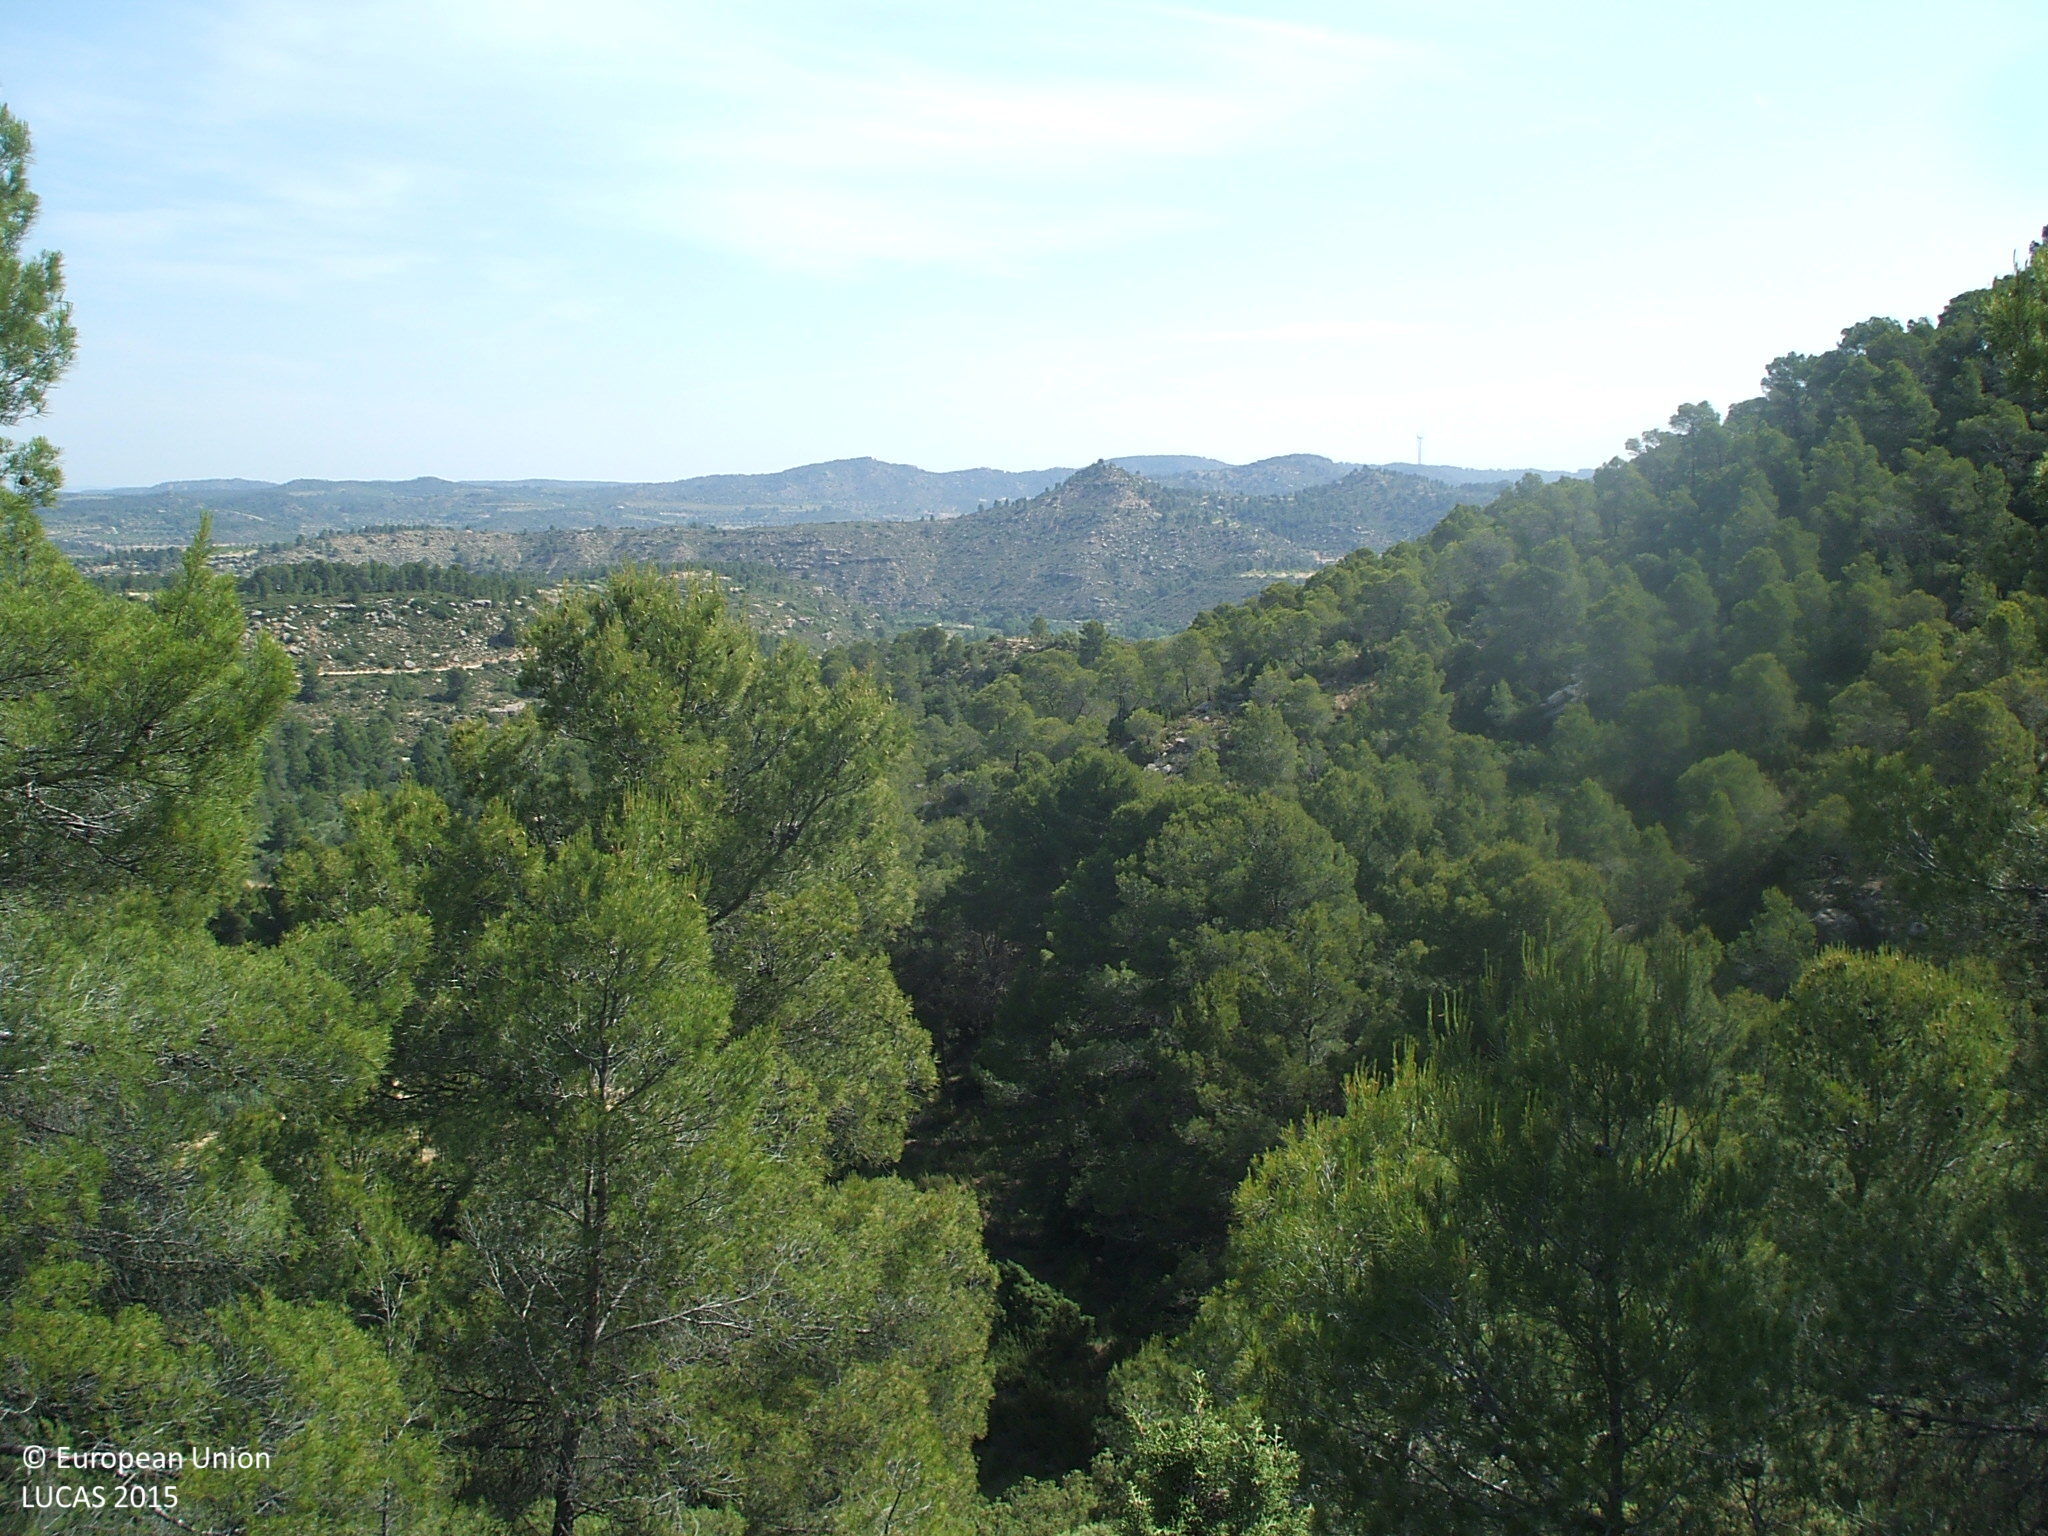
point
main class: Woodland
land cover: Pine dominated coniferous woodland
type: coniferous forest of the mediterranean region
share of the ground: > 75 %
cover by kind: coniferous forest trees 100 %
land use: Semi-natural and natural areas not in use
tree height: > 5 m
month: June
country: ES
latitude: 41.0343
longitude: 0.2251
